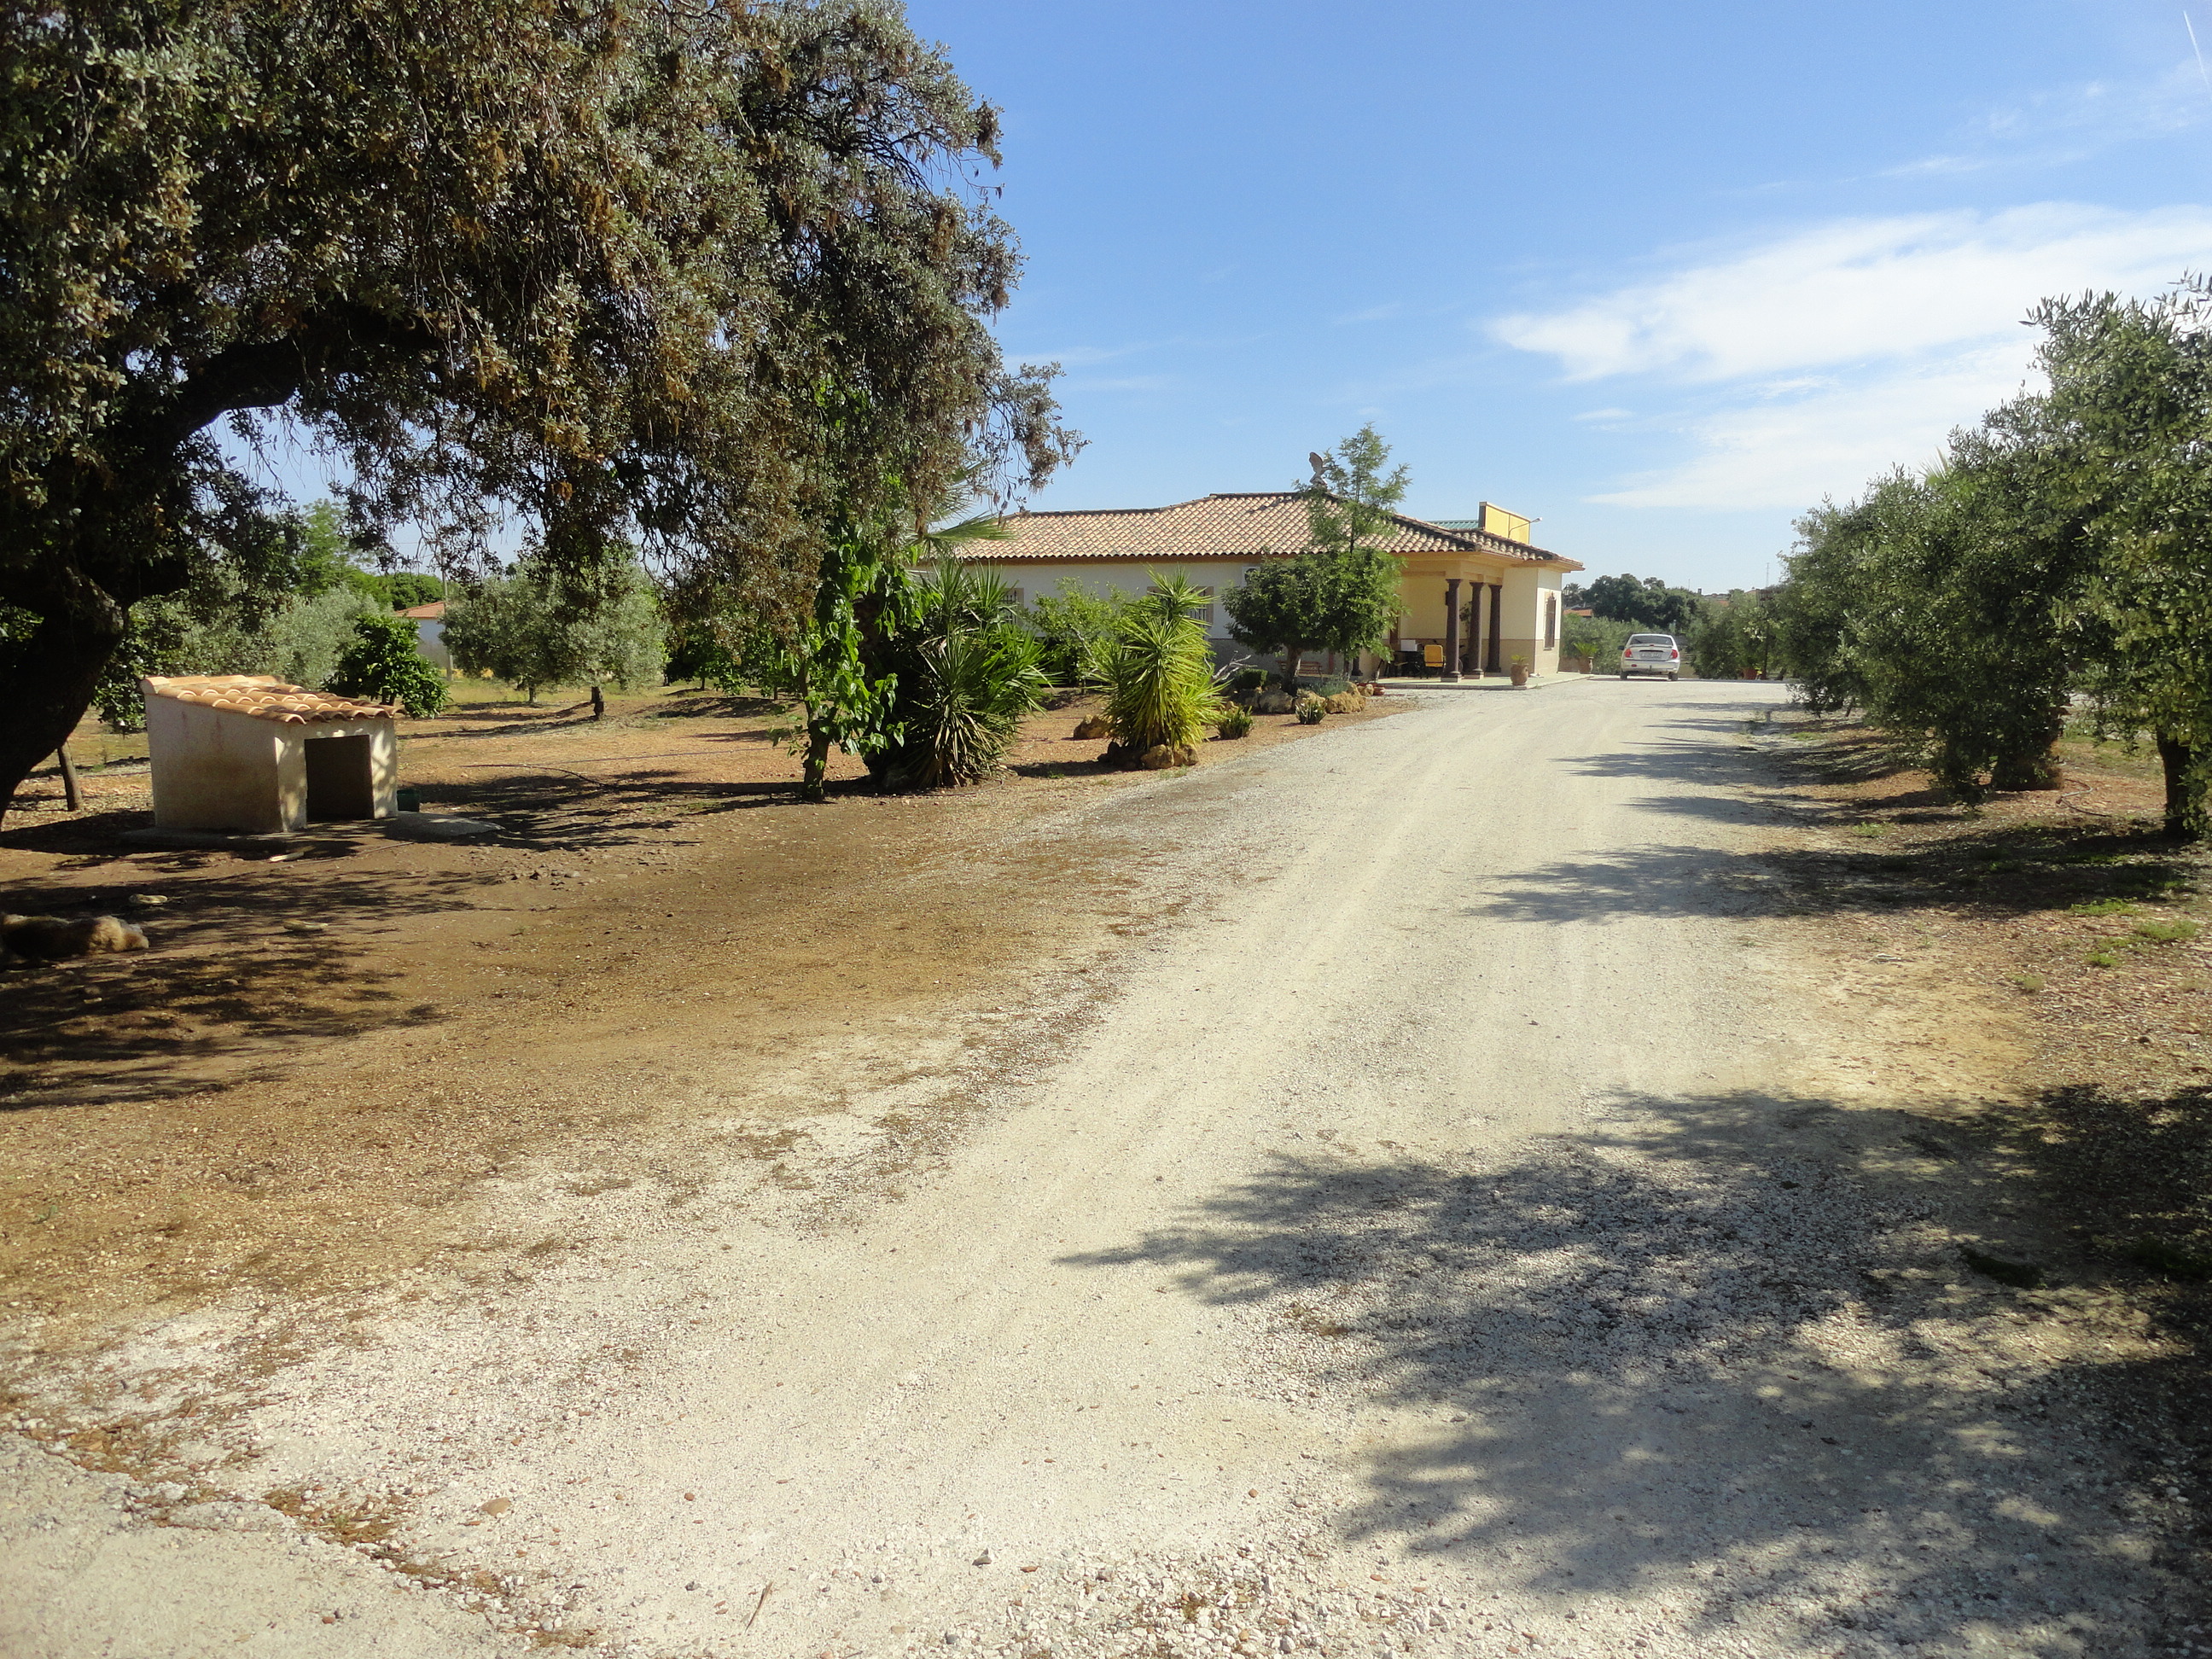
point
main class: Cropland
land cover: Olive groves
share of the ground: 10 - 25 %
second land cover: Other bare soil
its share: > 75 %
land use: Kitchen garden
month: May
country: ES
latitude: 37.7098
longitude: -4.8840
